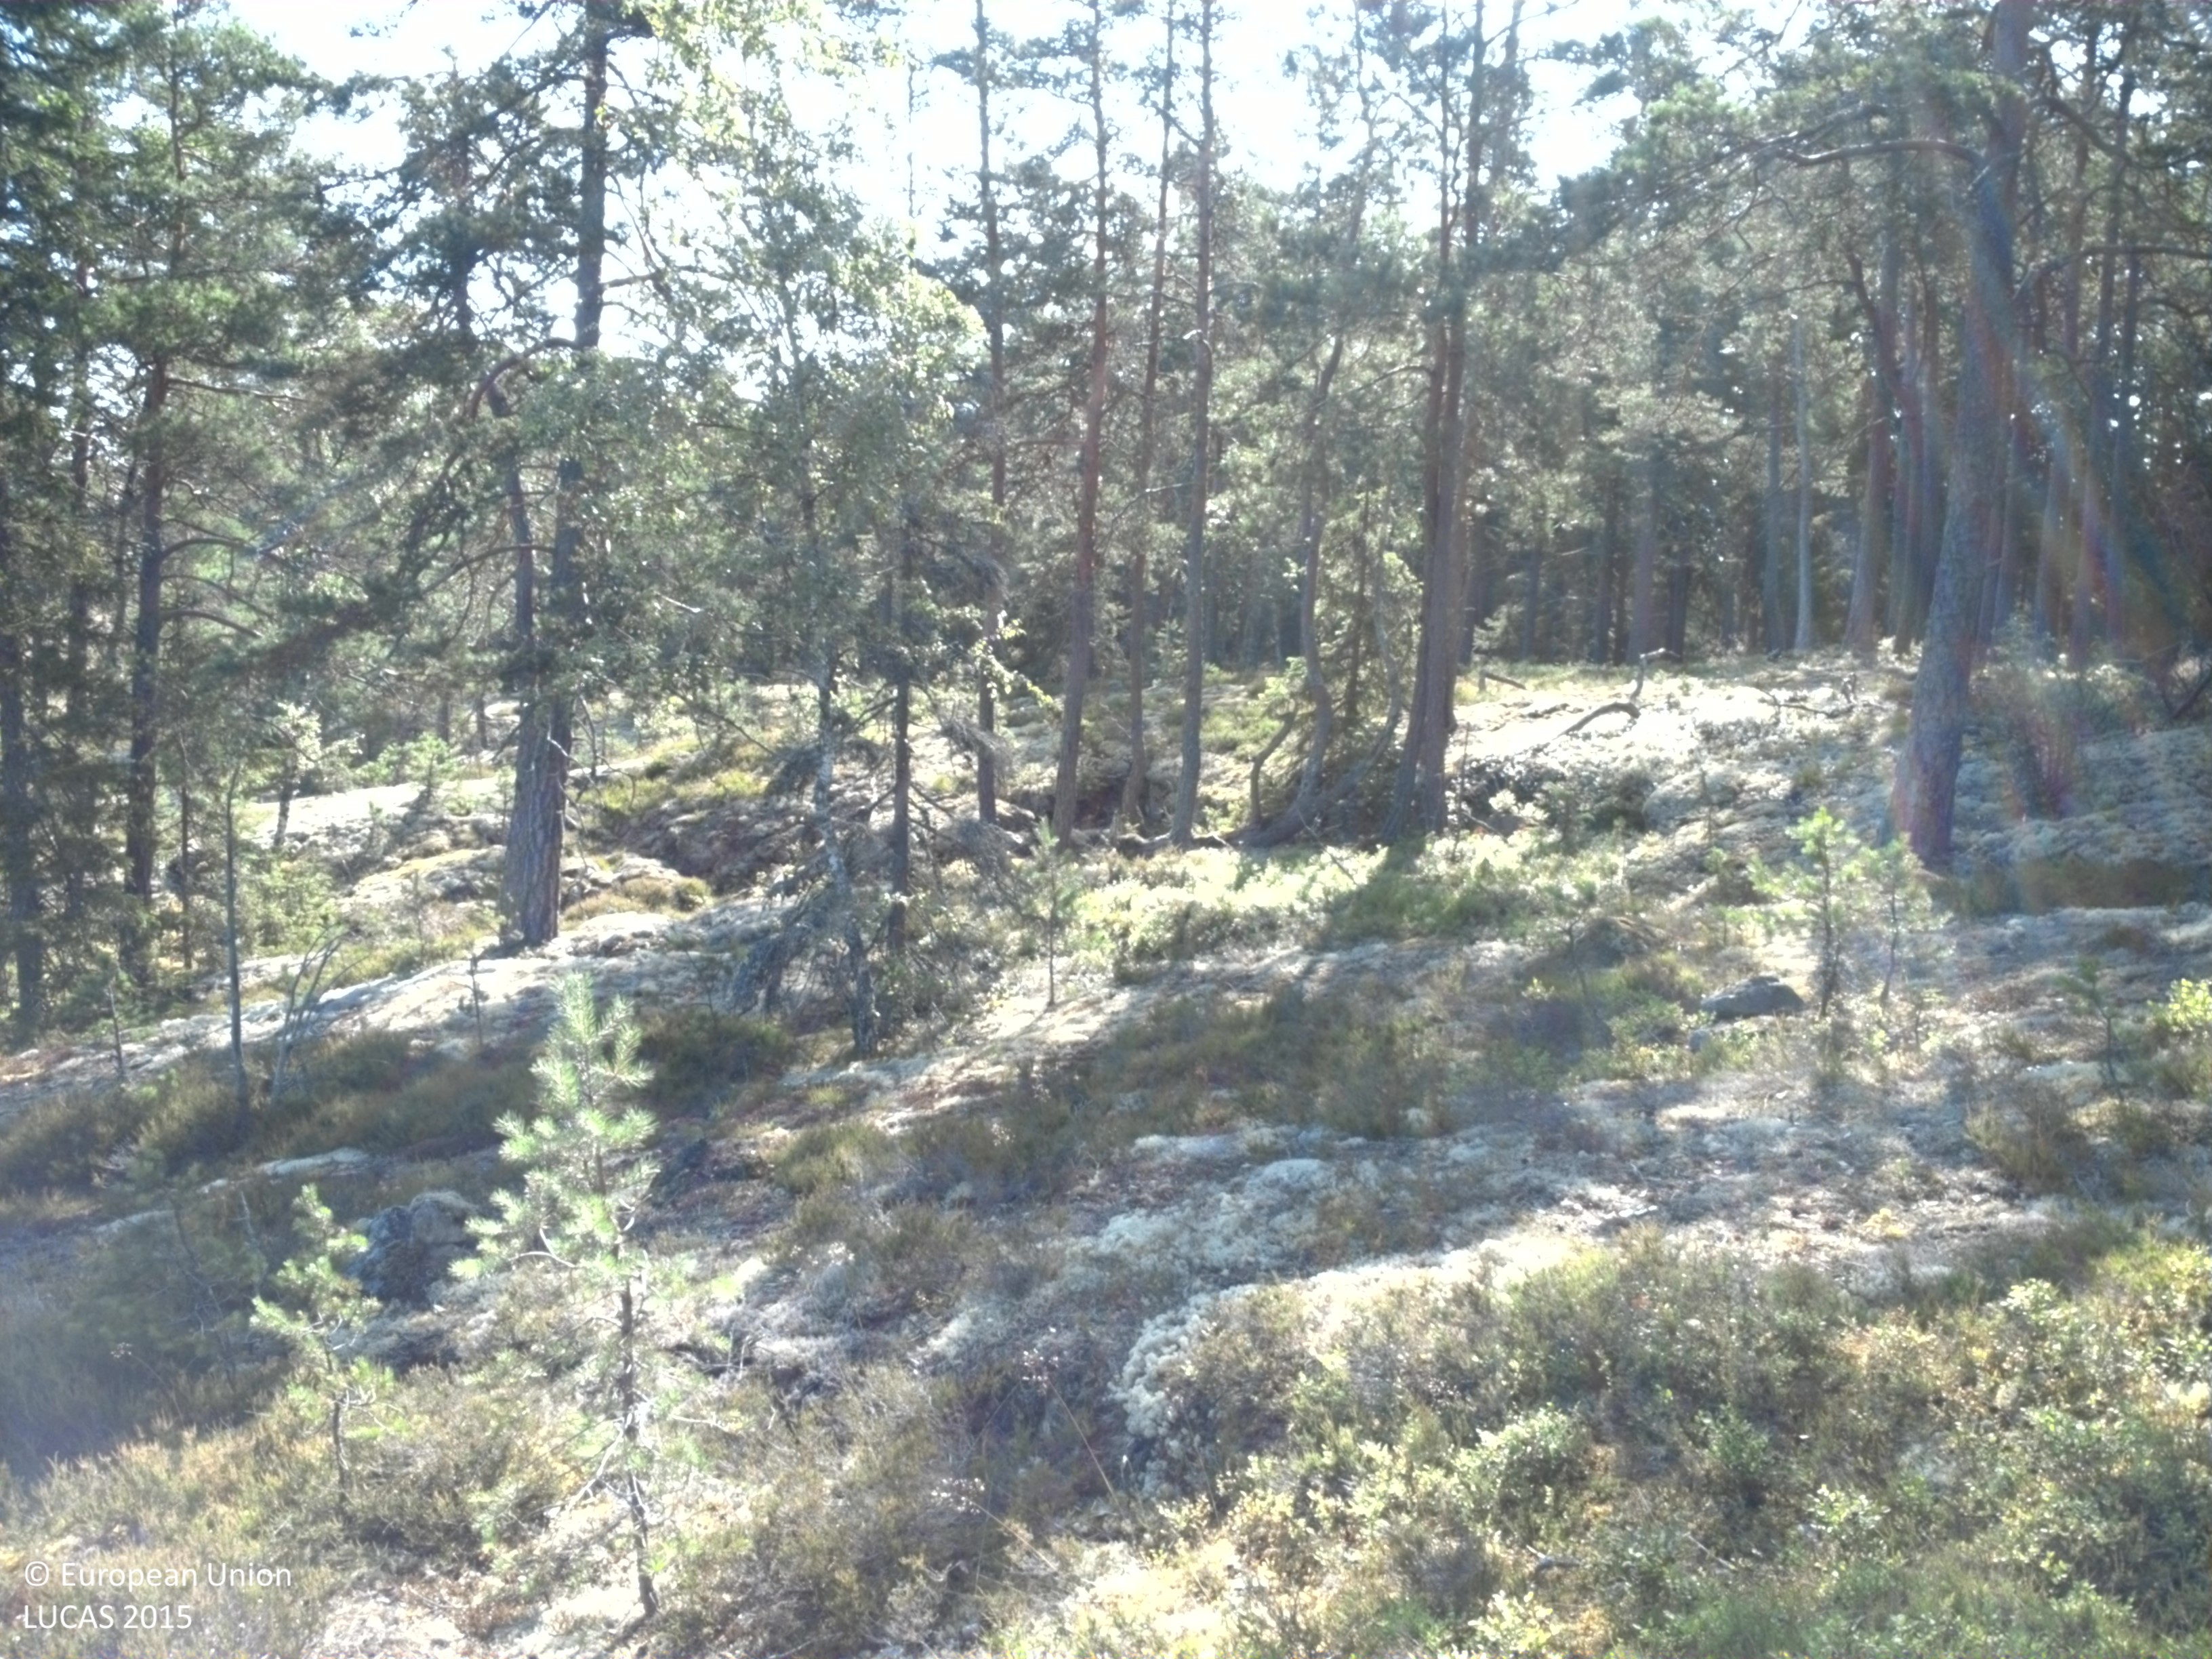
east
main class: Woodland
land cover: Pine dominated coniferous woodland
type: boreal forest
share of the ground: 25 - 50 %
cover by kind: coniferous forest trees 50 %, lichens and mosses 20 %, consolidated bare surface 20 %, shrubs 10 %
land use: Forestry
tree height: > 5 m
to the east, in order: Pine dominated coniferous woodland; Spruce dominated coniferous woodland; Pine dominated coniferous woodland; Spruce dominated mixed woodland
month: July
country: SE
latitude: 59.7058
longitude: 18.5123
